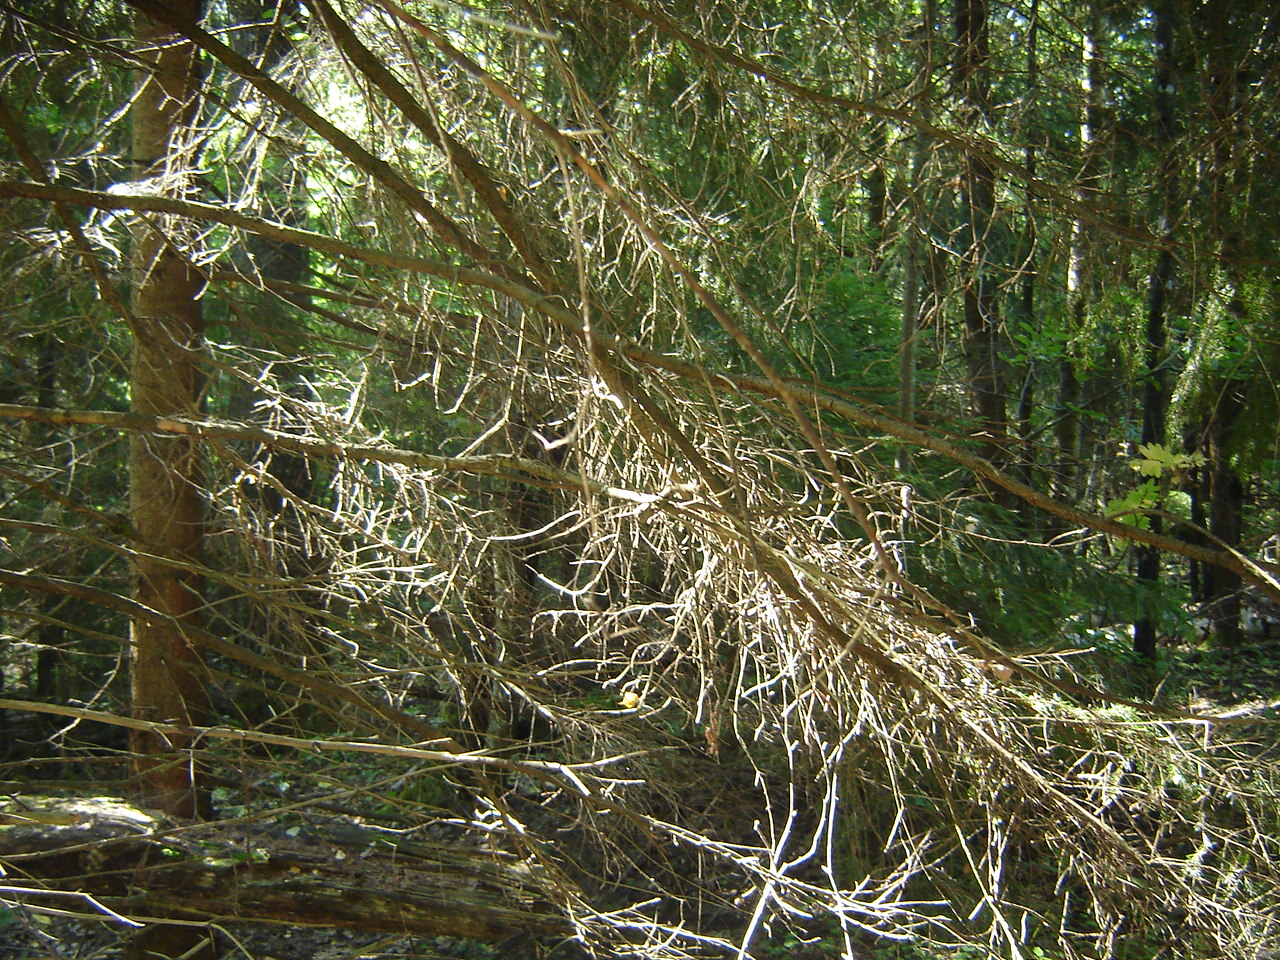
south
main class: Woodland
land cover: Other mixed woodland
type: hemiboreal forest and nemoral coniferous forest and mixed broadleaved-coniferous forest
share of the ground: > 75 %
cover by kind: coniferous forest trees 50 %, broadleaved forest trees 40 %, herbaceous plants 5 %, unconsolidated bare surface 5 %
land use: Forestry
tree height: > 5 m
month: August
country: LT
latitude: 55.0840
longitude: 25.1080
